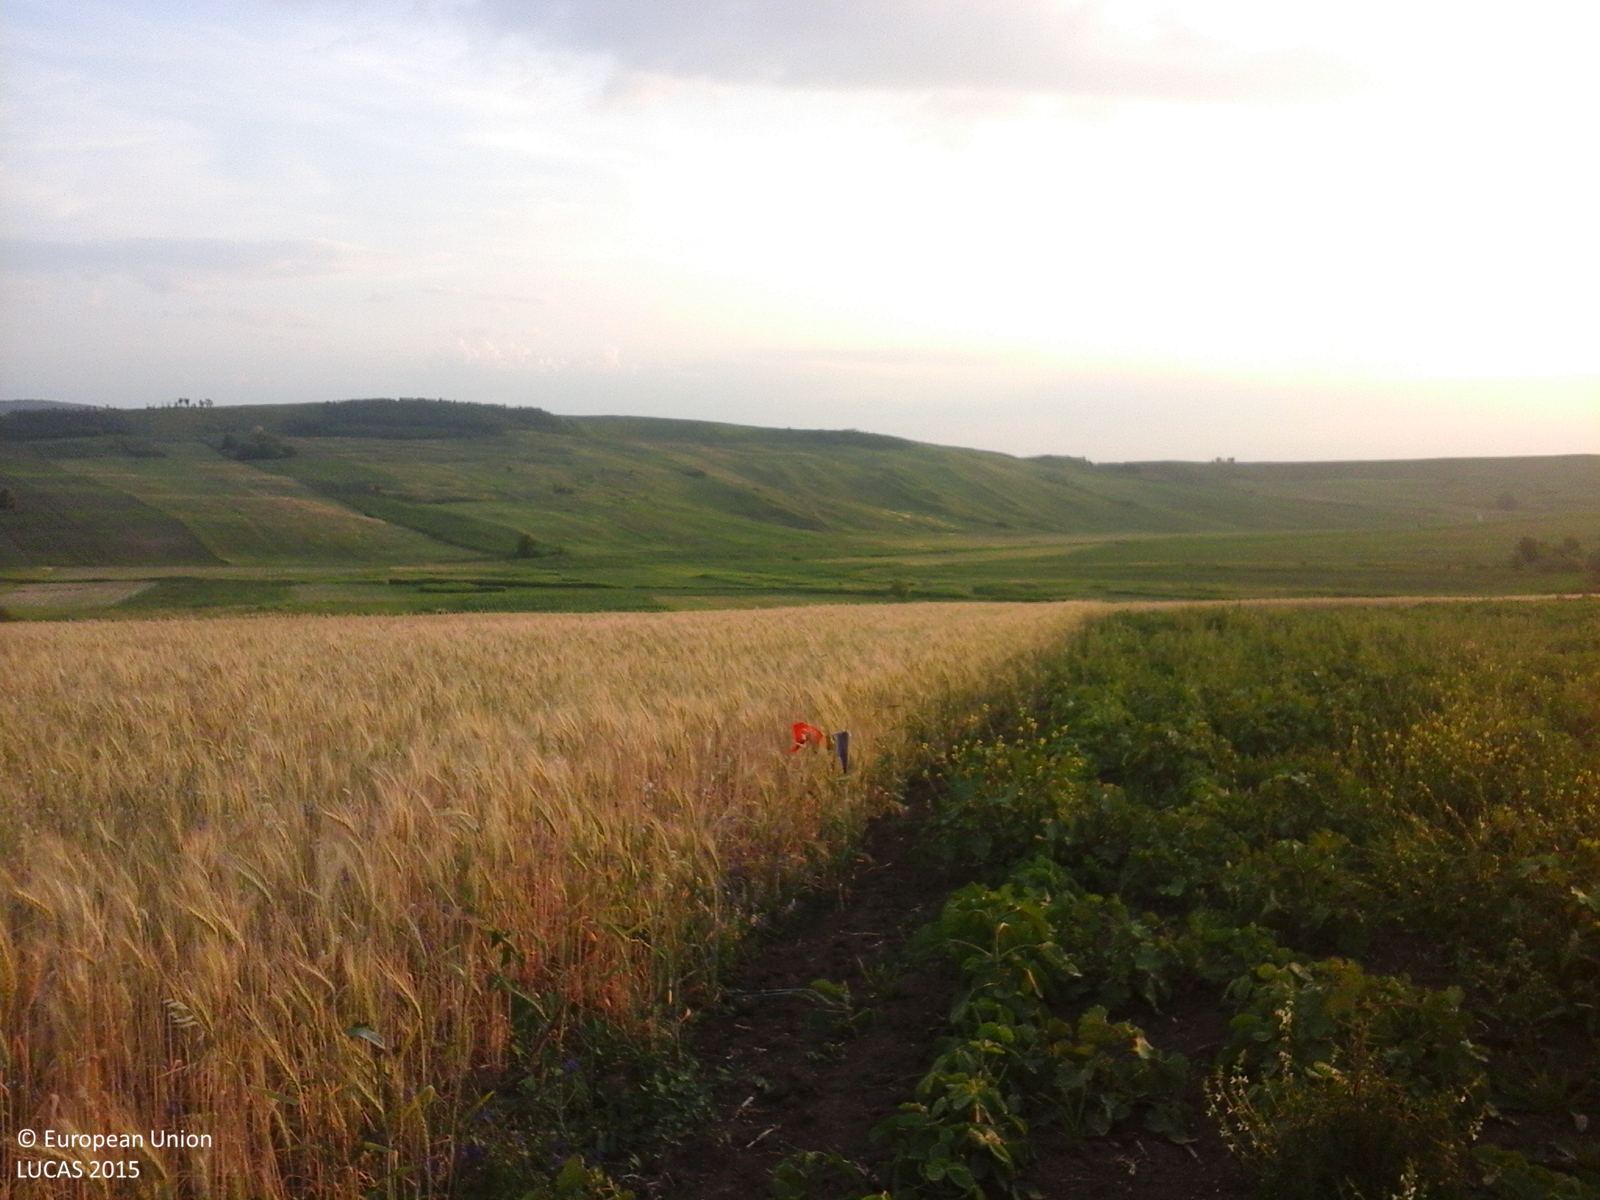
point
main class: Cropland
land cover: Soya
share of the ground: 50 - 75 %
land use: Agriculture (excluding fallow land and kitchen gardens)
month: June
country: RO
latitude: 46.8553
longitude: 27.3294
